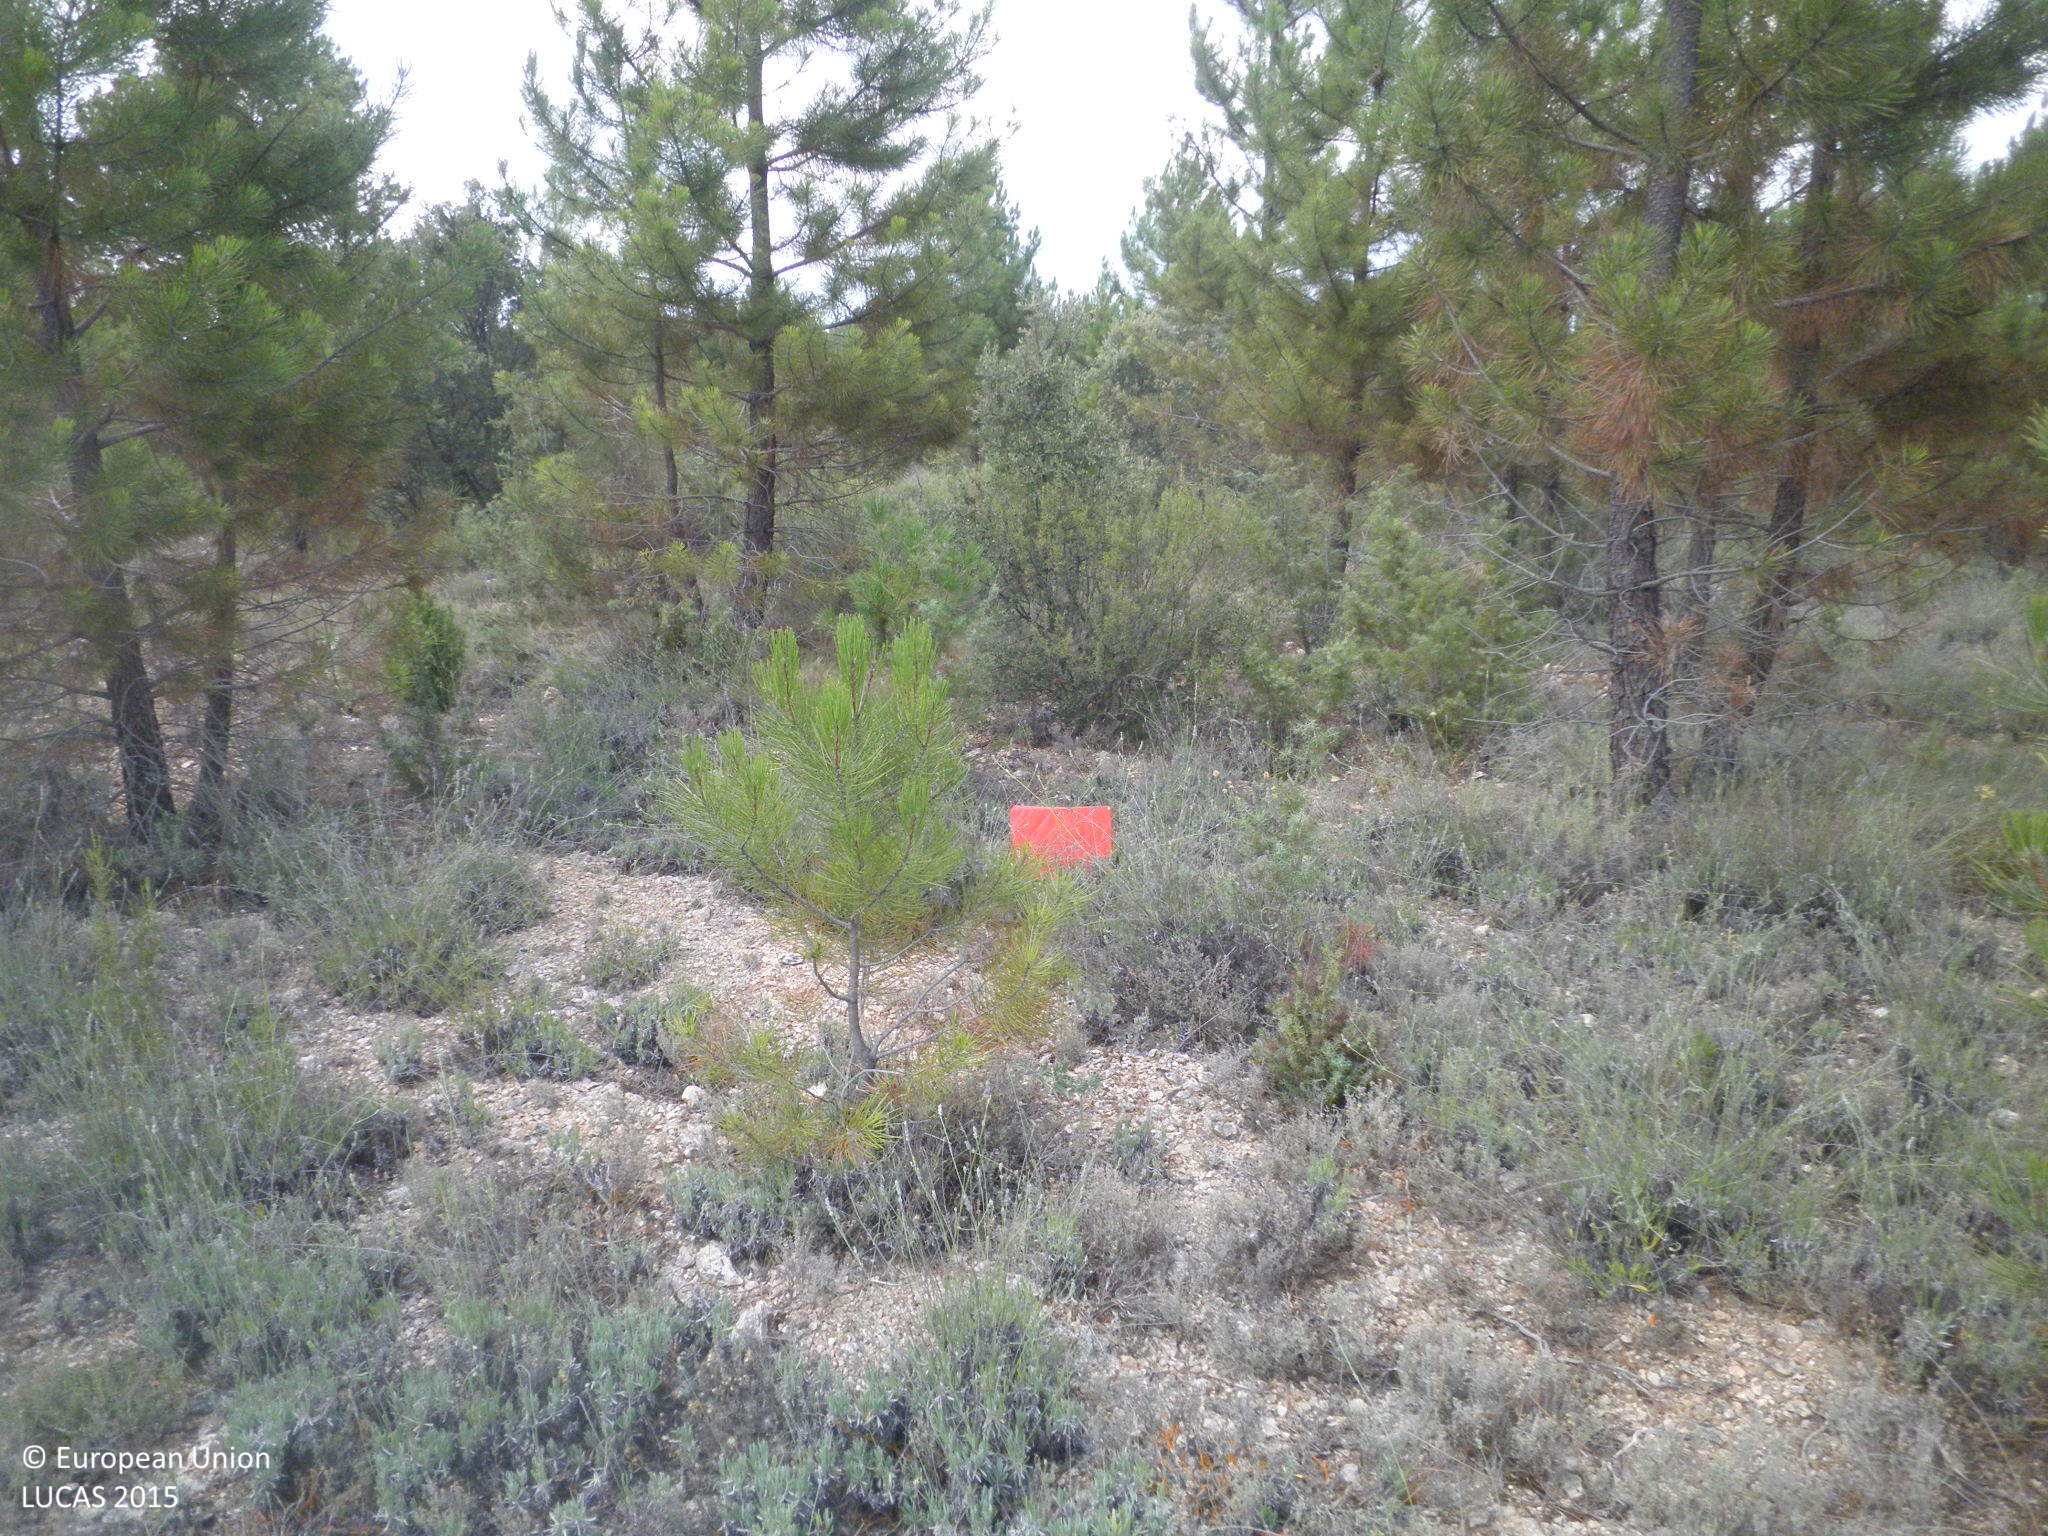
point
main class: Woodland
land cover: Pine dominated coniferous woodland
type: coniferous forest of the mediterranean region
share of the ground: 10 - 25 %
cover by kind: unconsolidated bare surface 40 %, coniferous forest trees 20 %, shrubs 20 %, herbaceous plants 20 %
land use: Semi-natural and natural areas not in use
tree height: < 5 m
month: July
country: ES
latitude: 39.7440
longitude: -1.8779
